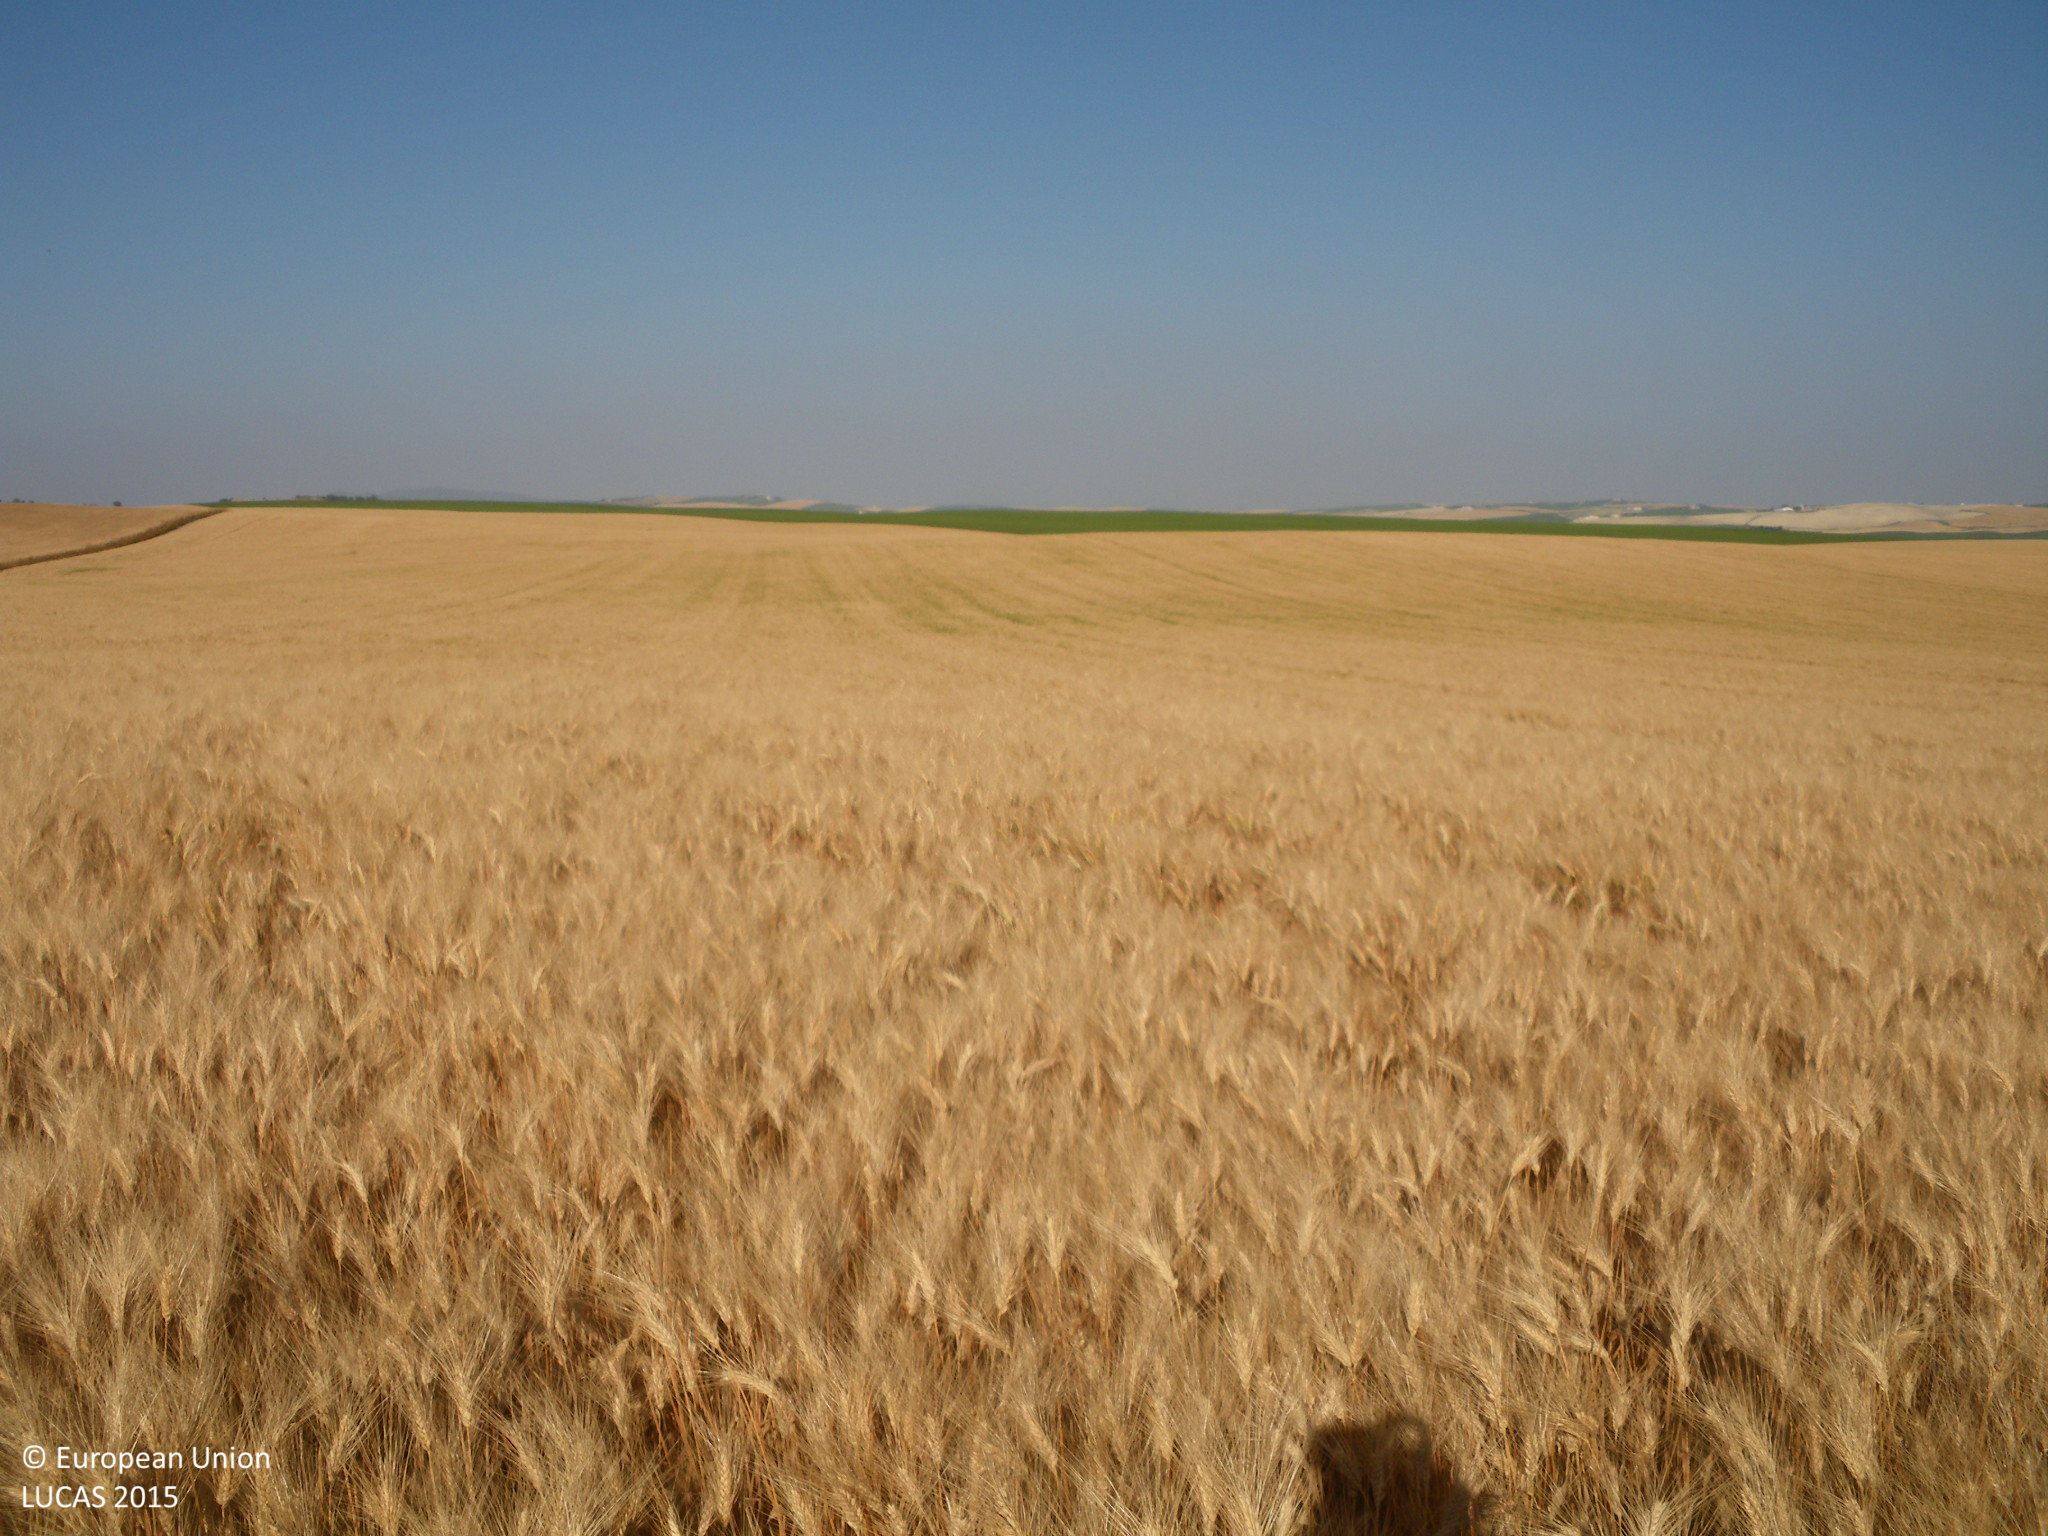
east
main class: Cropland
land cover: Durum wheat
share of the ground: > 75 %
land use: Agriculture (excluding fallow land and kitchen gardens)
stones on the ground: < 10 %
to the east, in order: Durum wheat
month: May
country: ES
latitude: 36.7683
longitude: -6.2263
